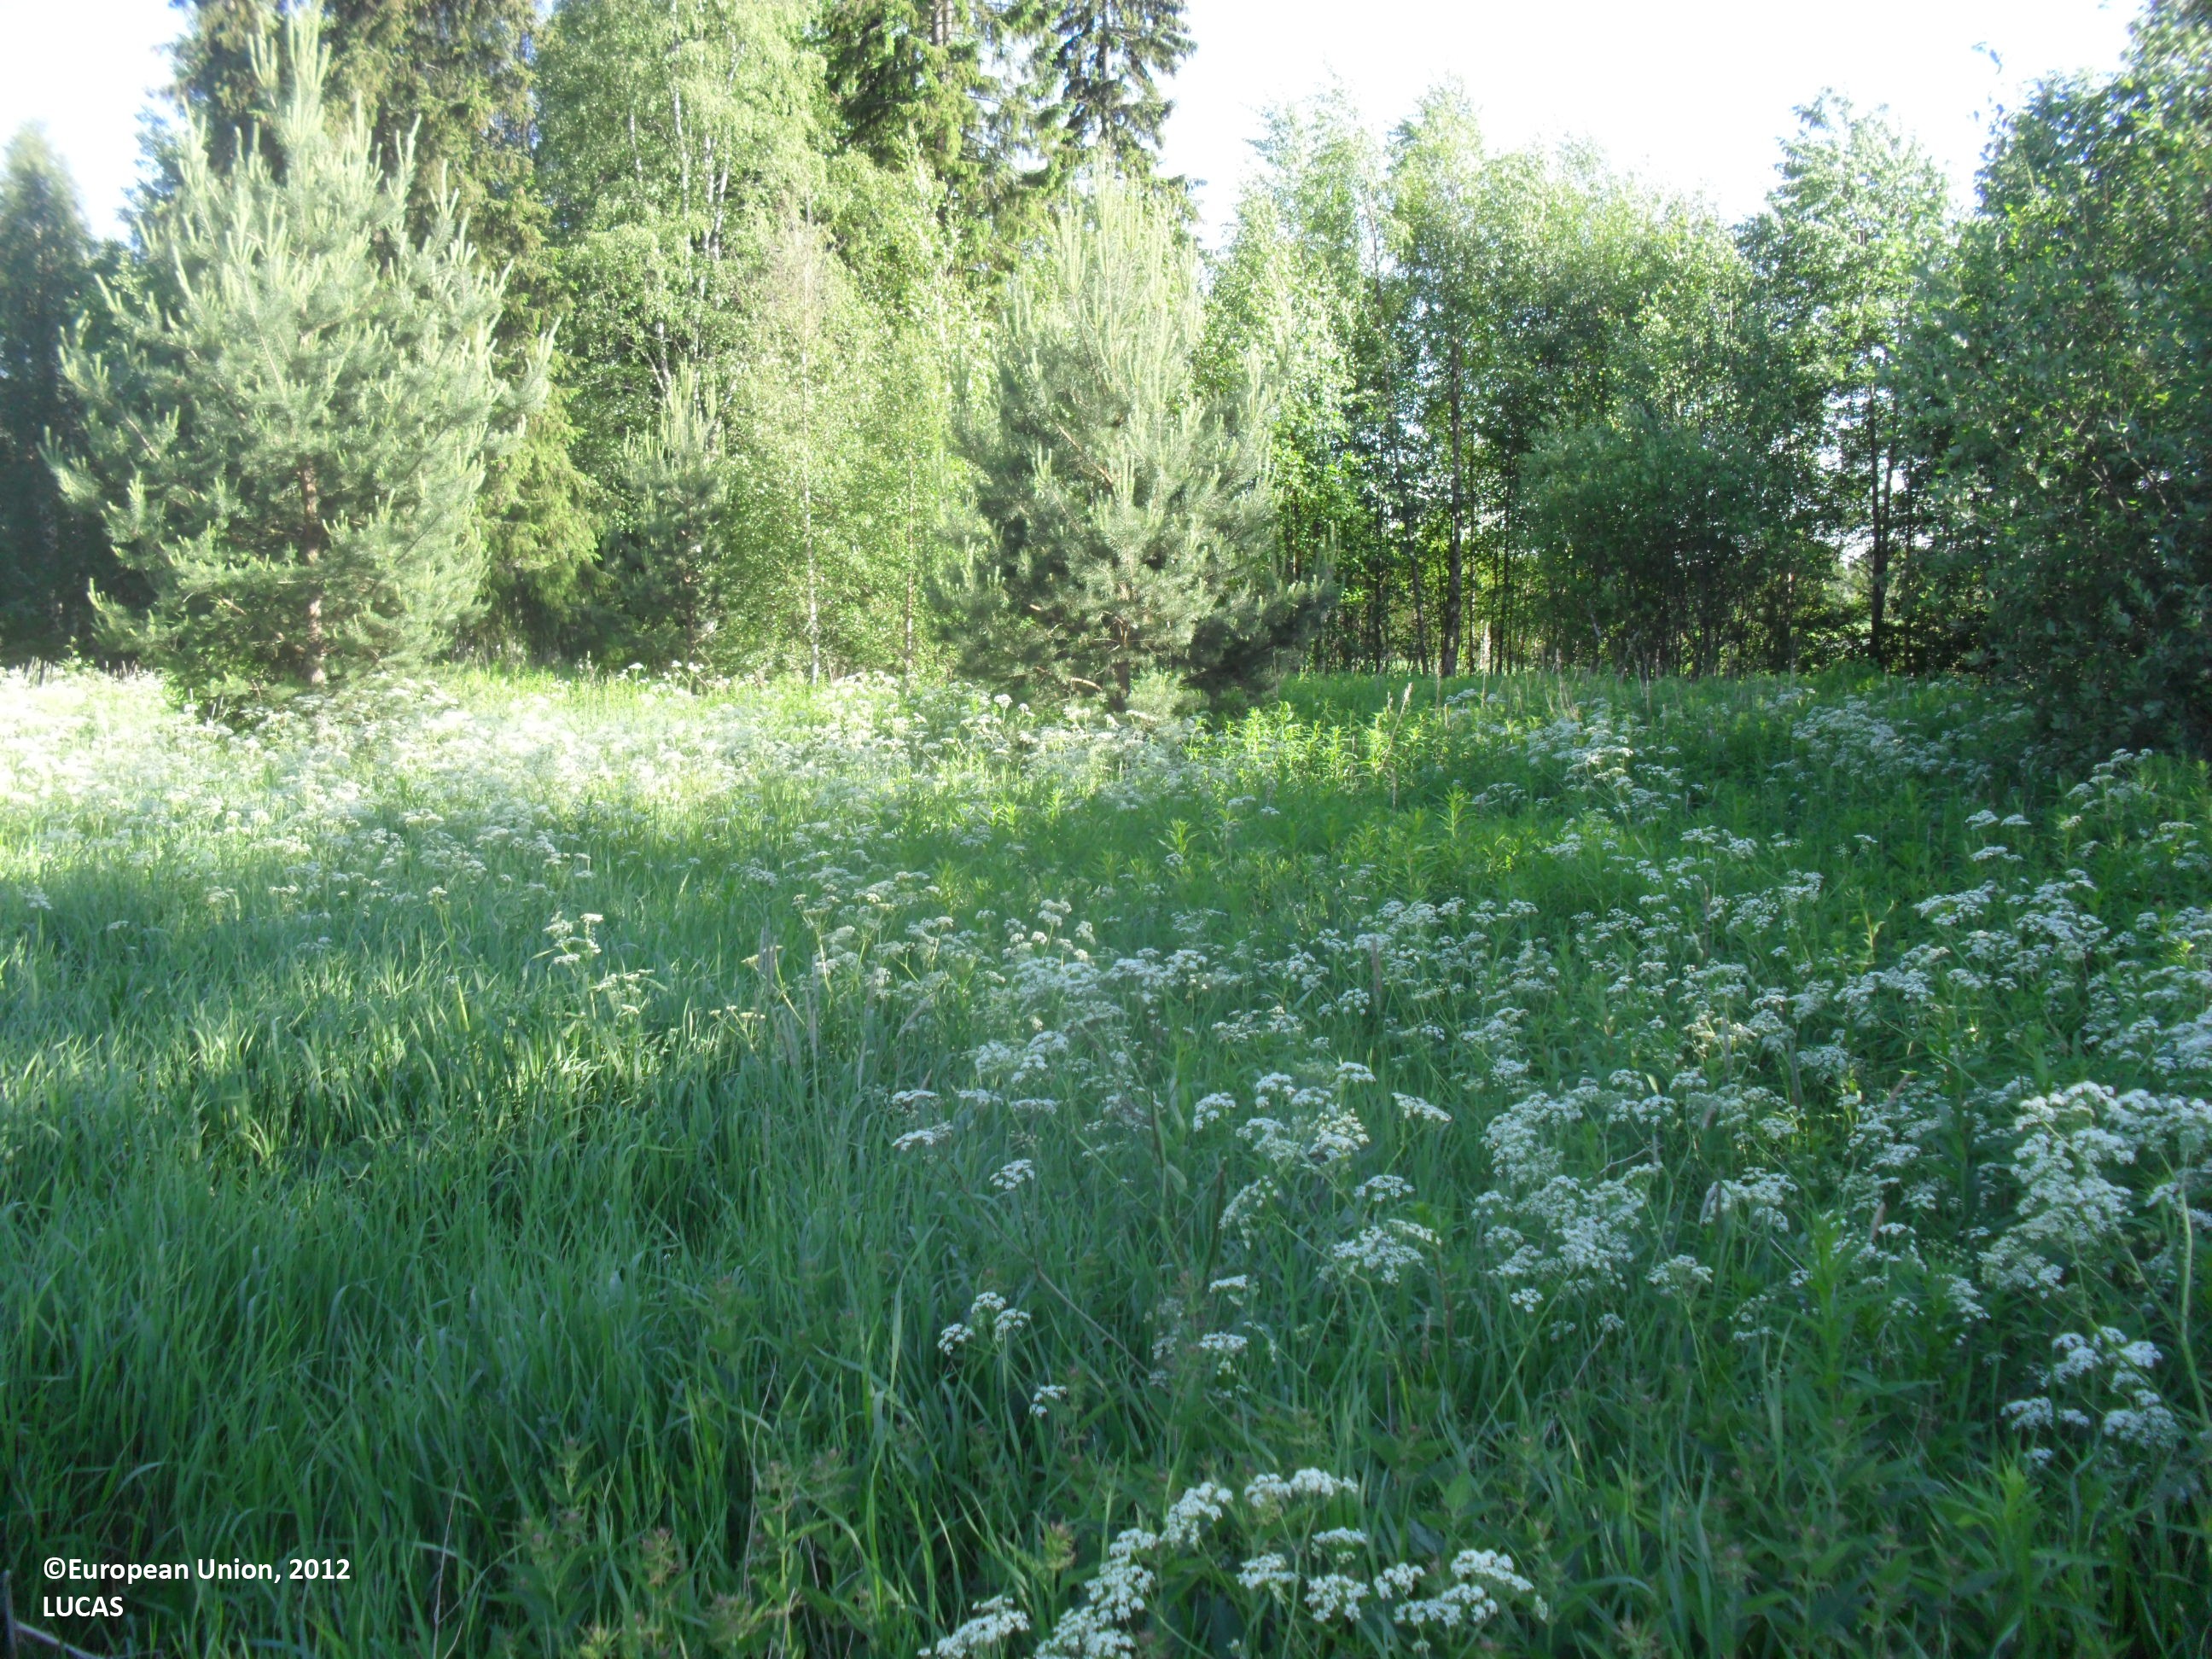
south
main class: Grassland
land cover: Spontaneously vegetated surfaces
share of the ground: > 75 %
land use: Abandoned areas
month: June
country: FI
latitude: 62.9876
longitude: 23.7475
